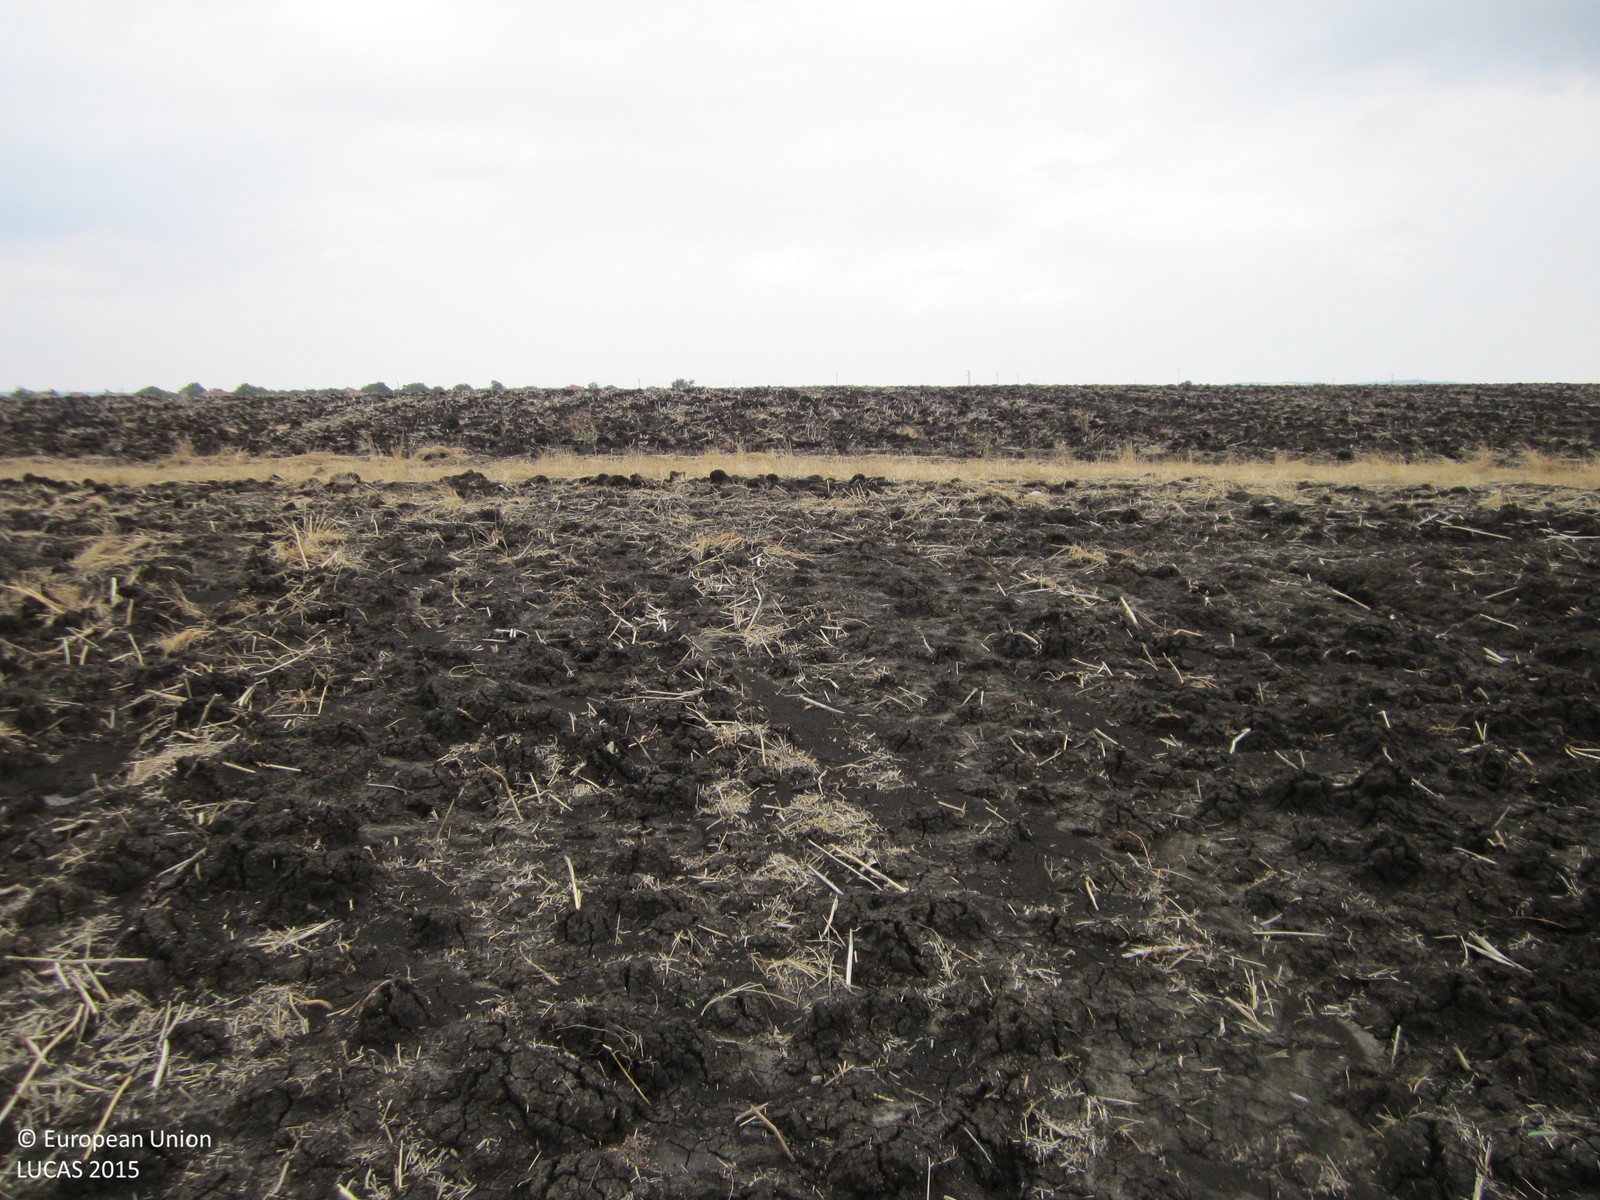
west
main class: Cropland
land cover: Sunflower
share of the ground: < 10 %
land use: Agriculture (excluding fallow land and kitchen gardens)
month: August
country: BG
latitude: 42.5318
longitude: 26.9911
